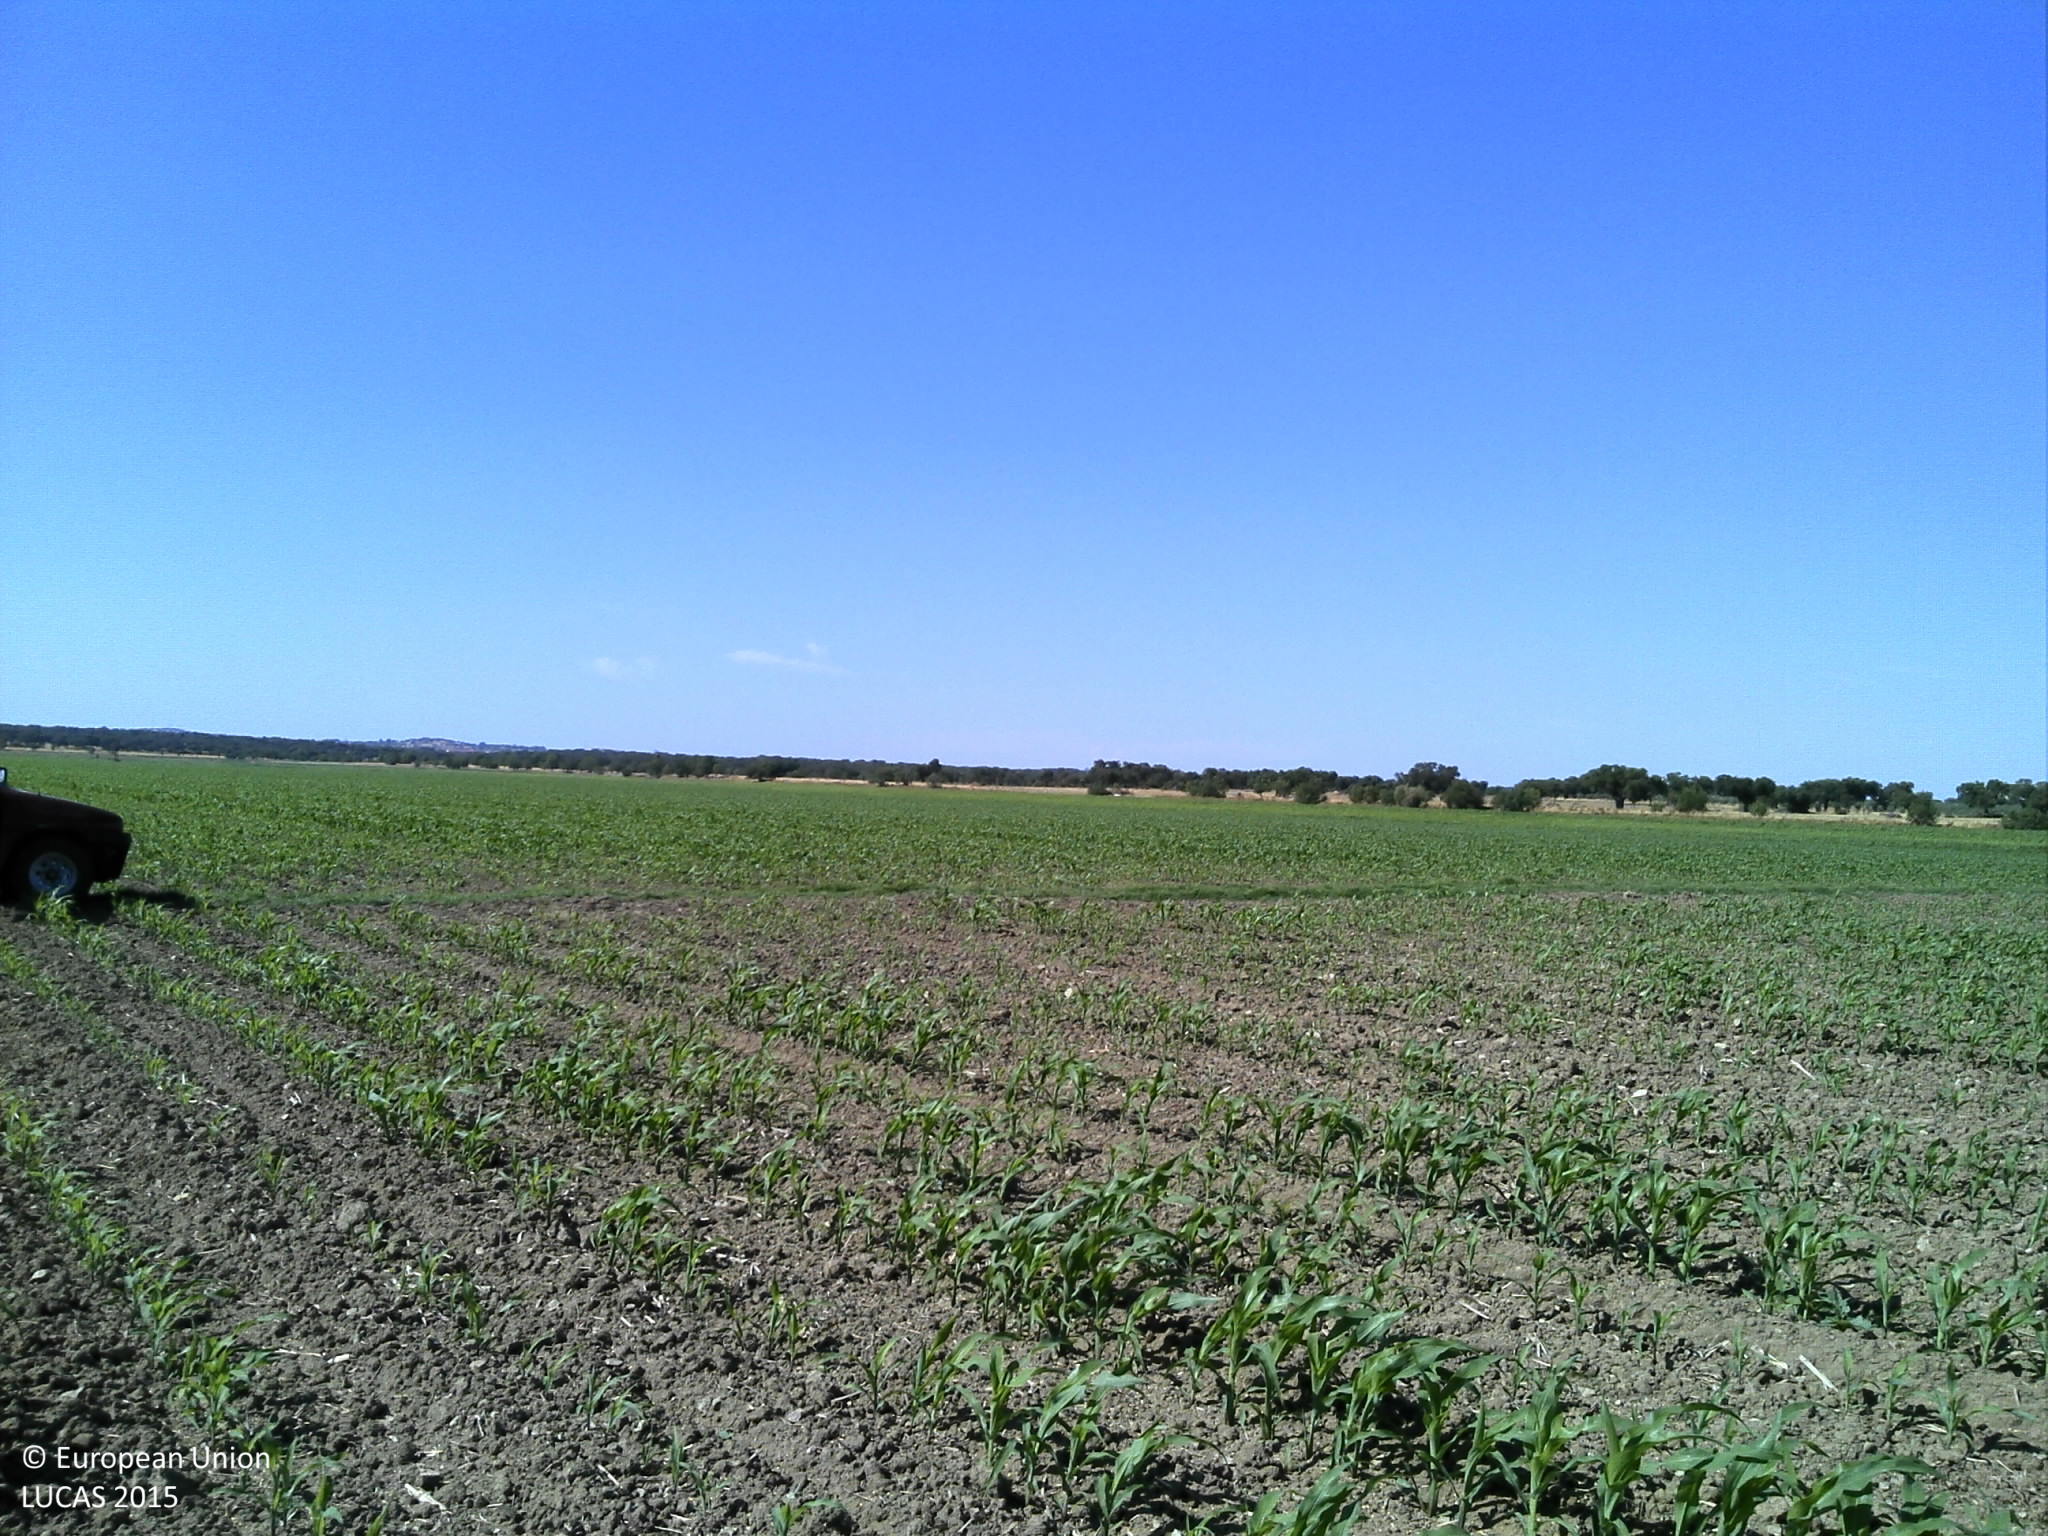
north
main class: Cropland
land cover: Maize
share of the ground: 10 - 25 %
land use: Agriculture (excluding fallow land and kitchen gardens)
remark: Temporary dry
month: June
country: PT
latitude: 38.3186
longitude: -8.1463
